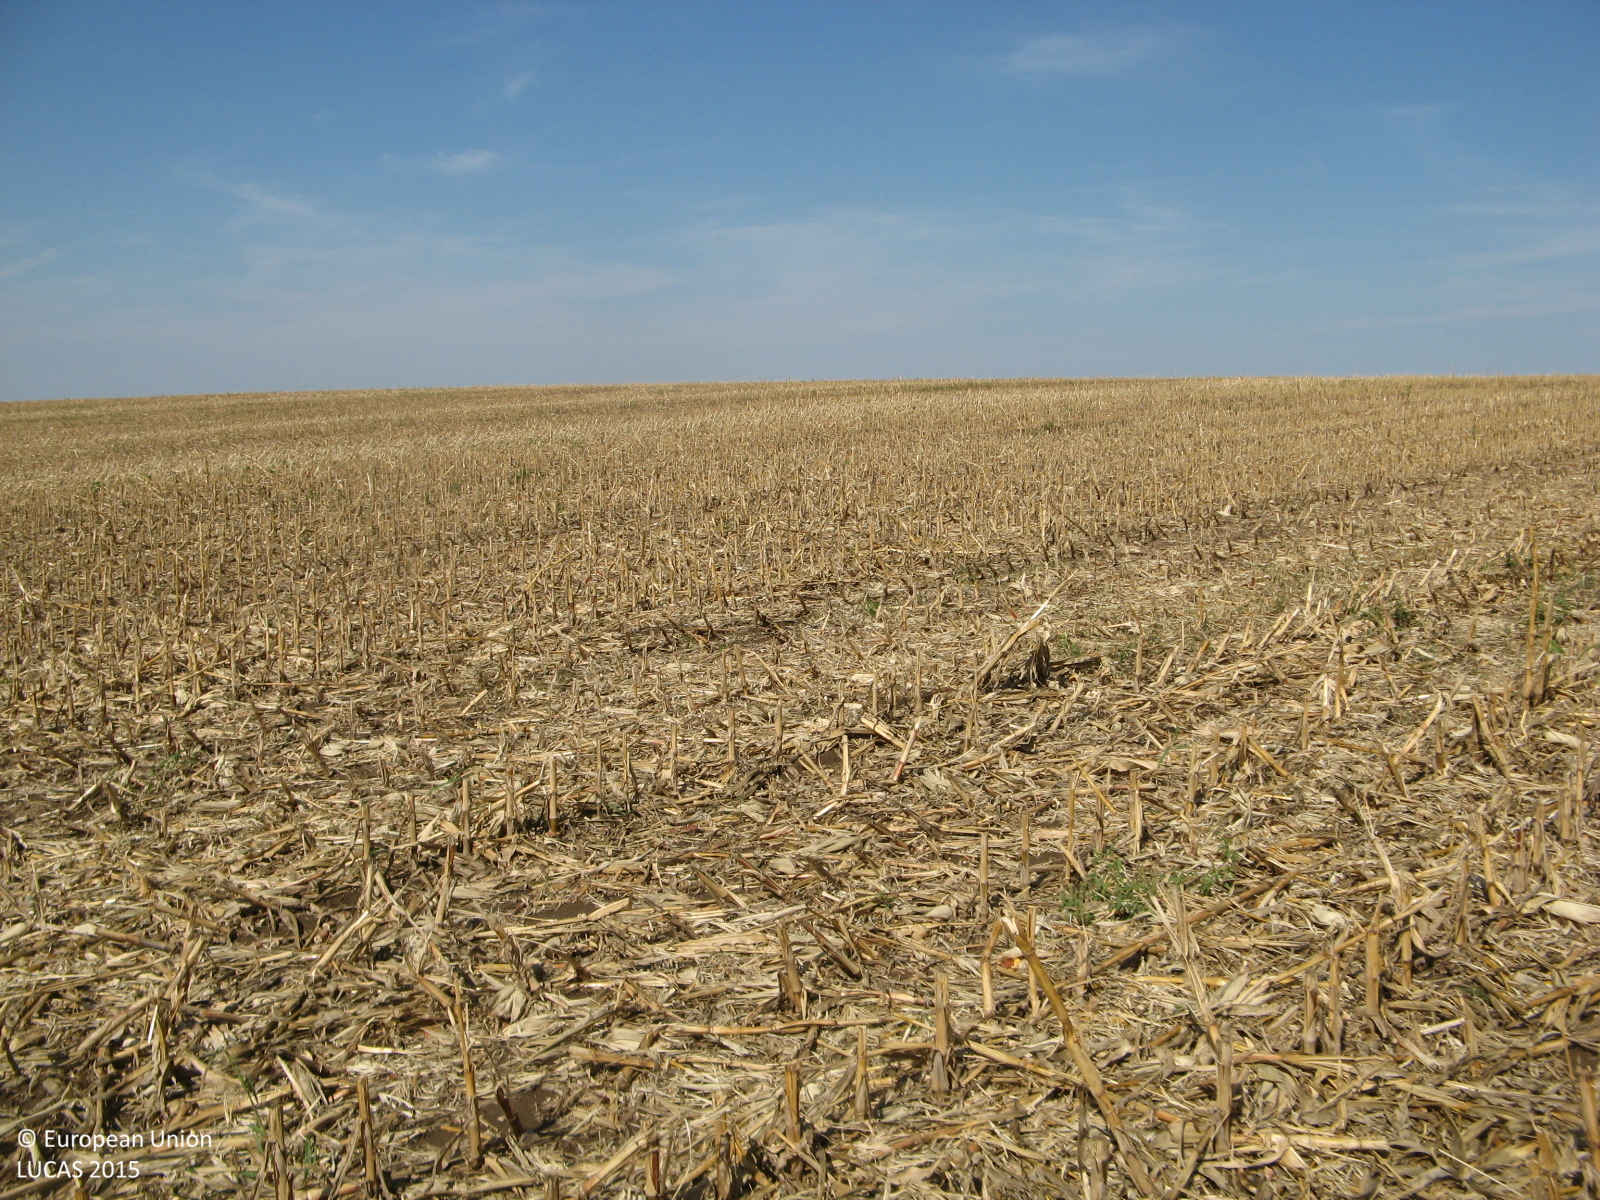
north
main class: Cropland
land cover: Maize
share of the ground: 10 - 25 %
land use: Agriculture (excluding fallow land and kitchen gardens)
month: September
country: BG
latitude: 43.5686
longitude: 25.6997
